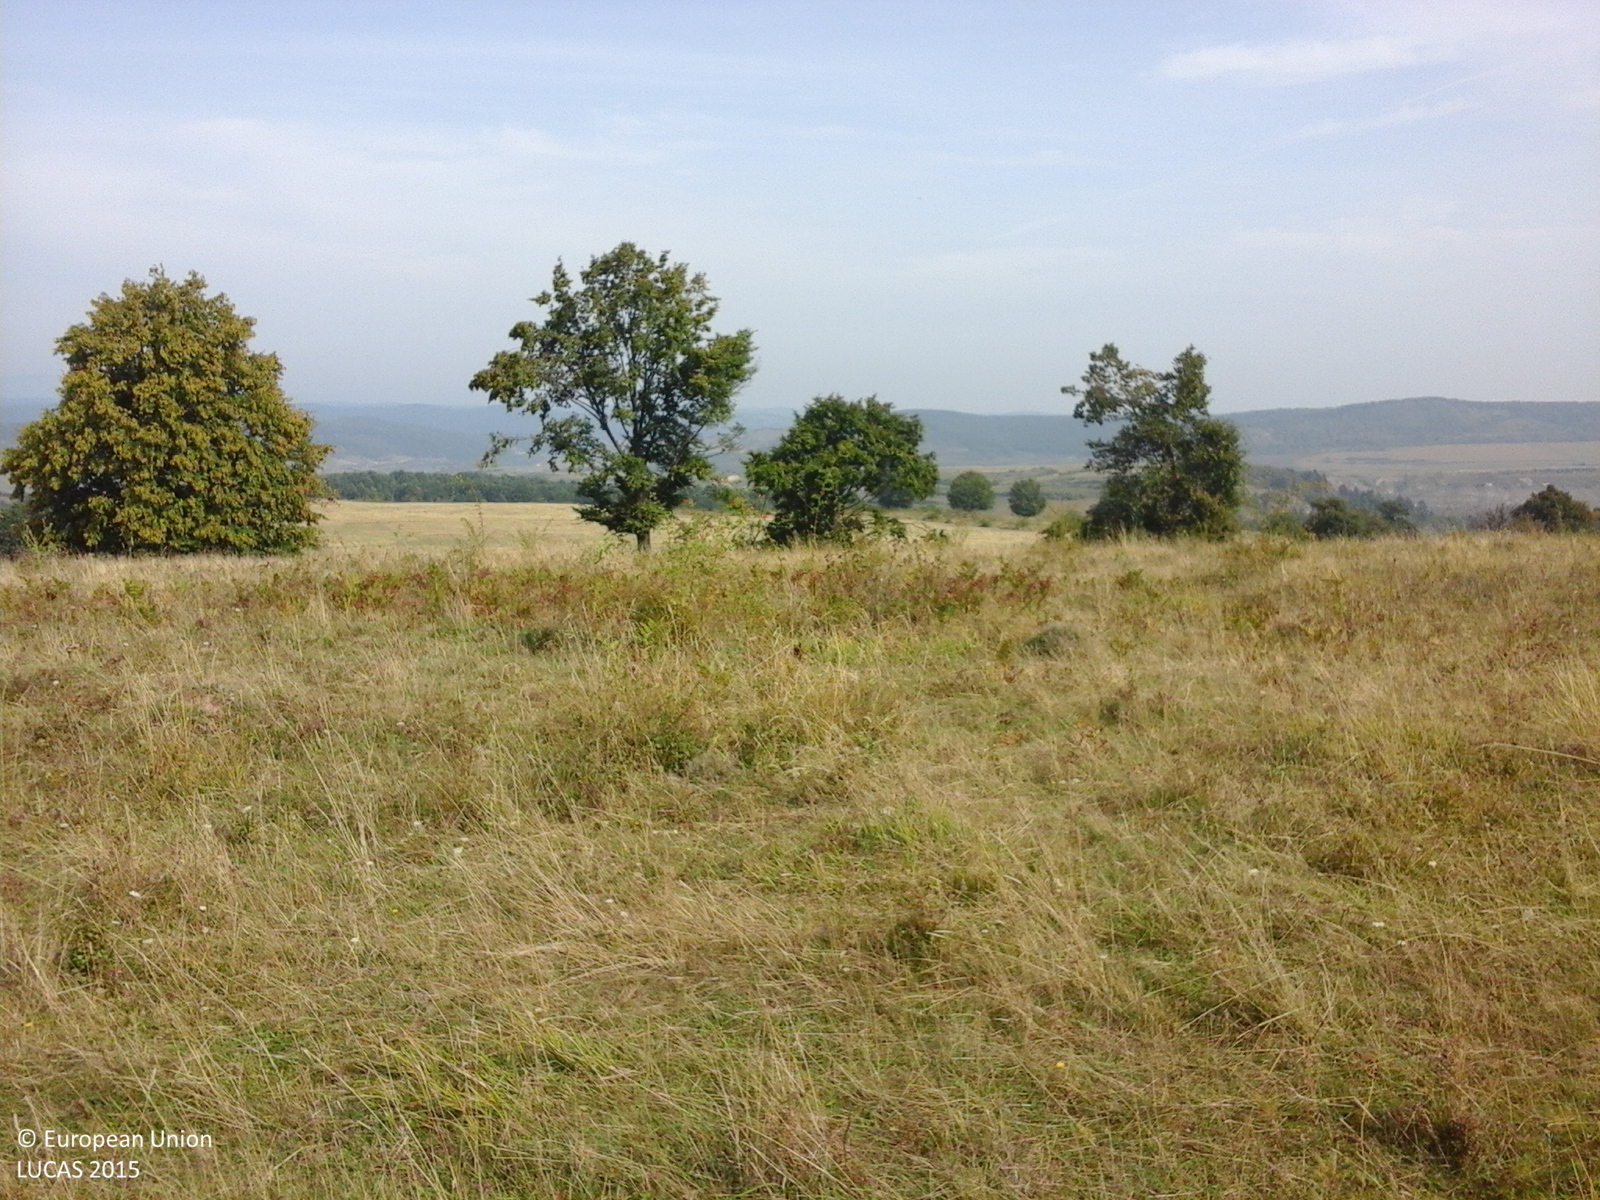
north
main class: Grassland
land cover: Grassland with sparse tree/shrub cover
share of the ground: > 75 %
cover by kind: herbaceous plants 85 %, shrubs 10 %, broadleaved forest trees 5 %
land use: Fallow land
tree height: < 5 m
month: September
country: RO
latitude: 46.8736
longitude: 23.0914
